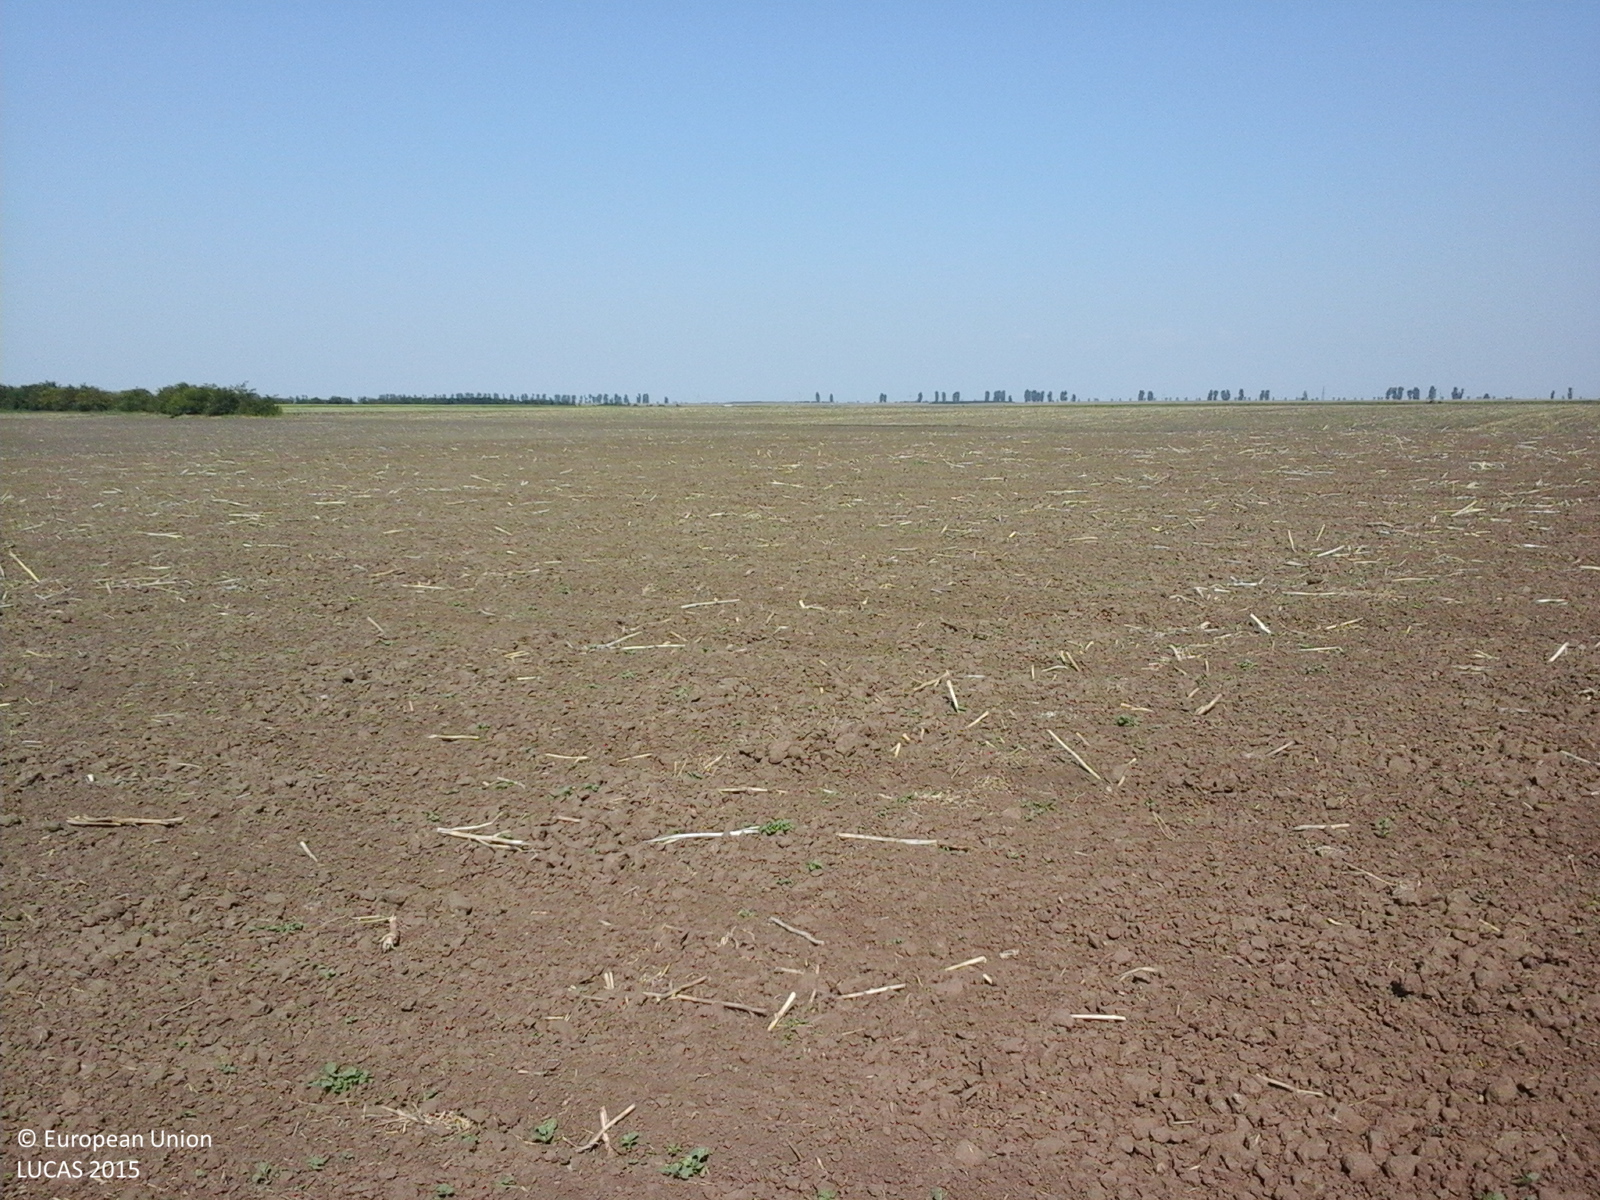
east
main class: Cropland
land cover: Common wheat
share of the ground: < 10 %
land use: Agriculture (excluding fallow land and kitchen gardens)
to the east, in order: Common wheat
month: July
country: RO
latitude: 44.9036
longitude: 27.2240
